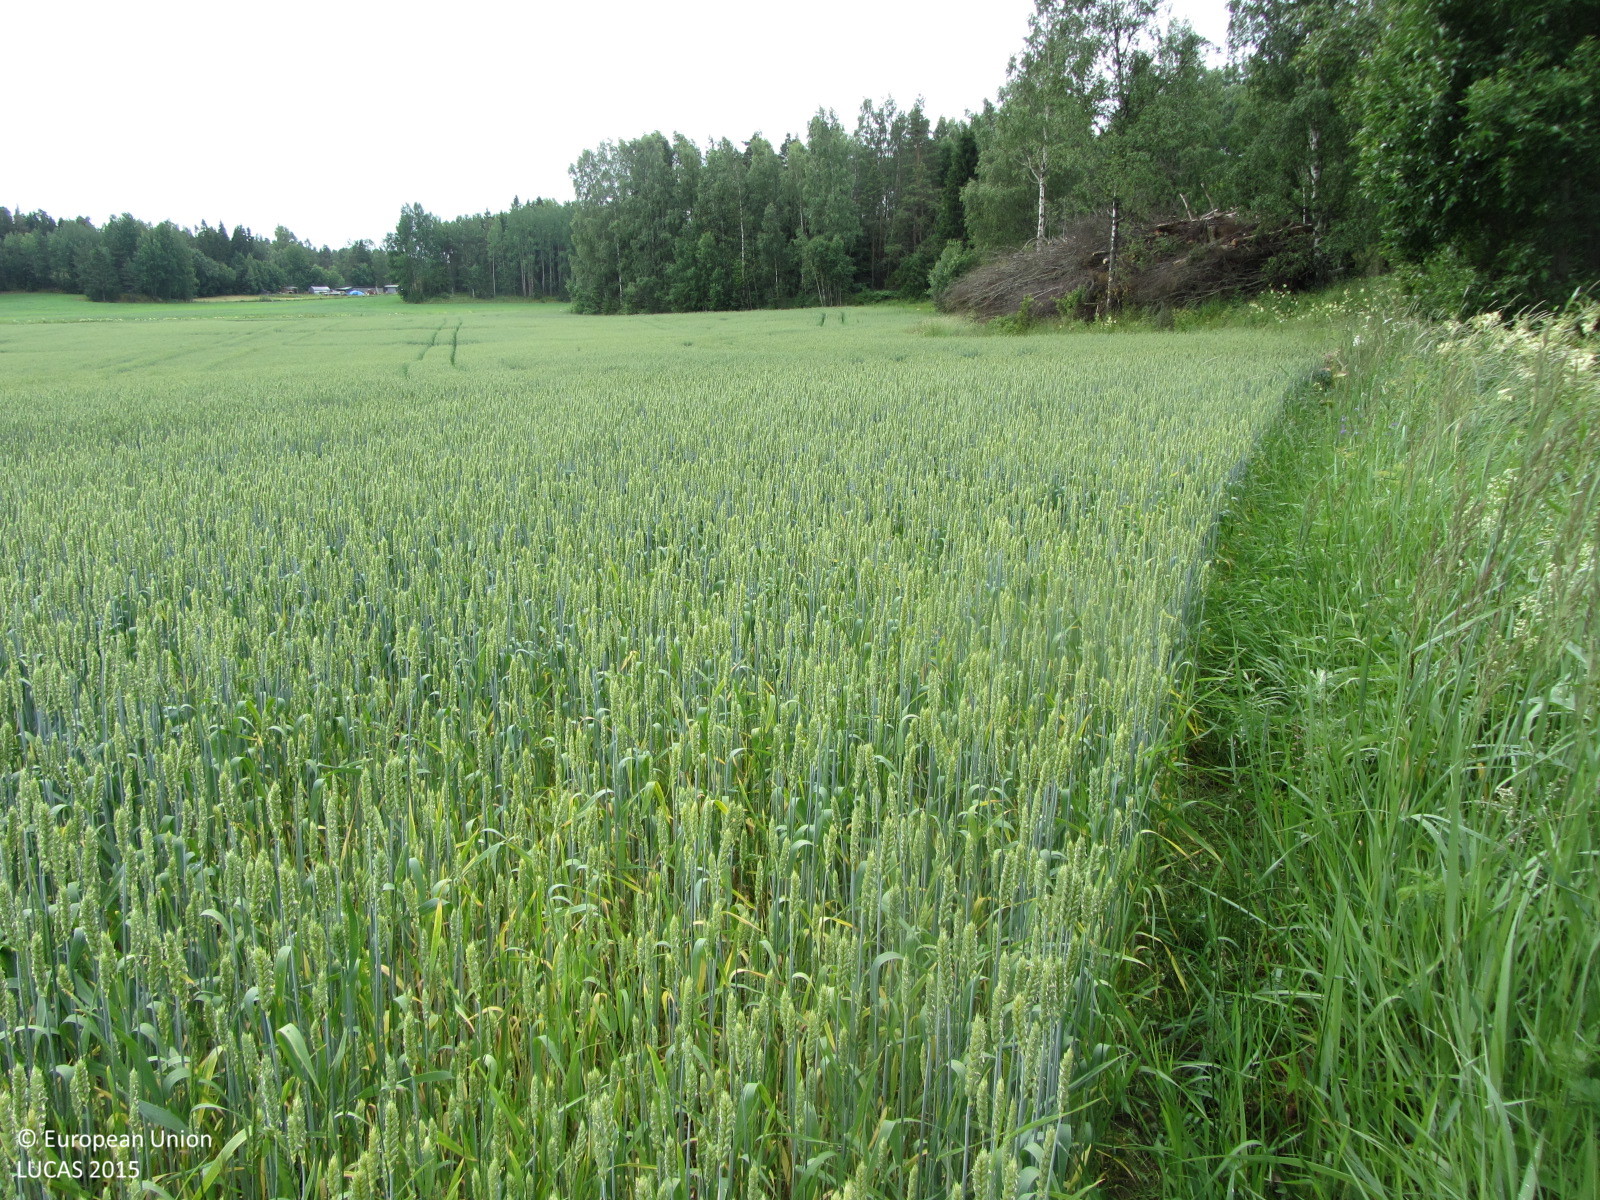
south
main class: Cropland
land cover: Common wheat
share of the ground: > 75 %
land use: Agriculture (excluding fallow land and kitchen gardens)
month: July
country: FI
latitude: 60.0583
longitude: 24.0566
